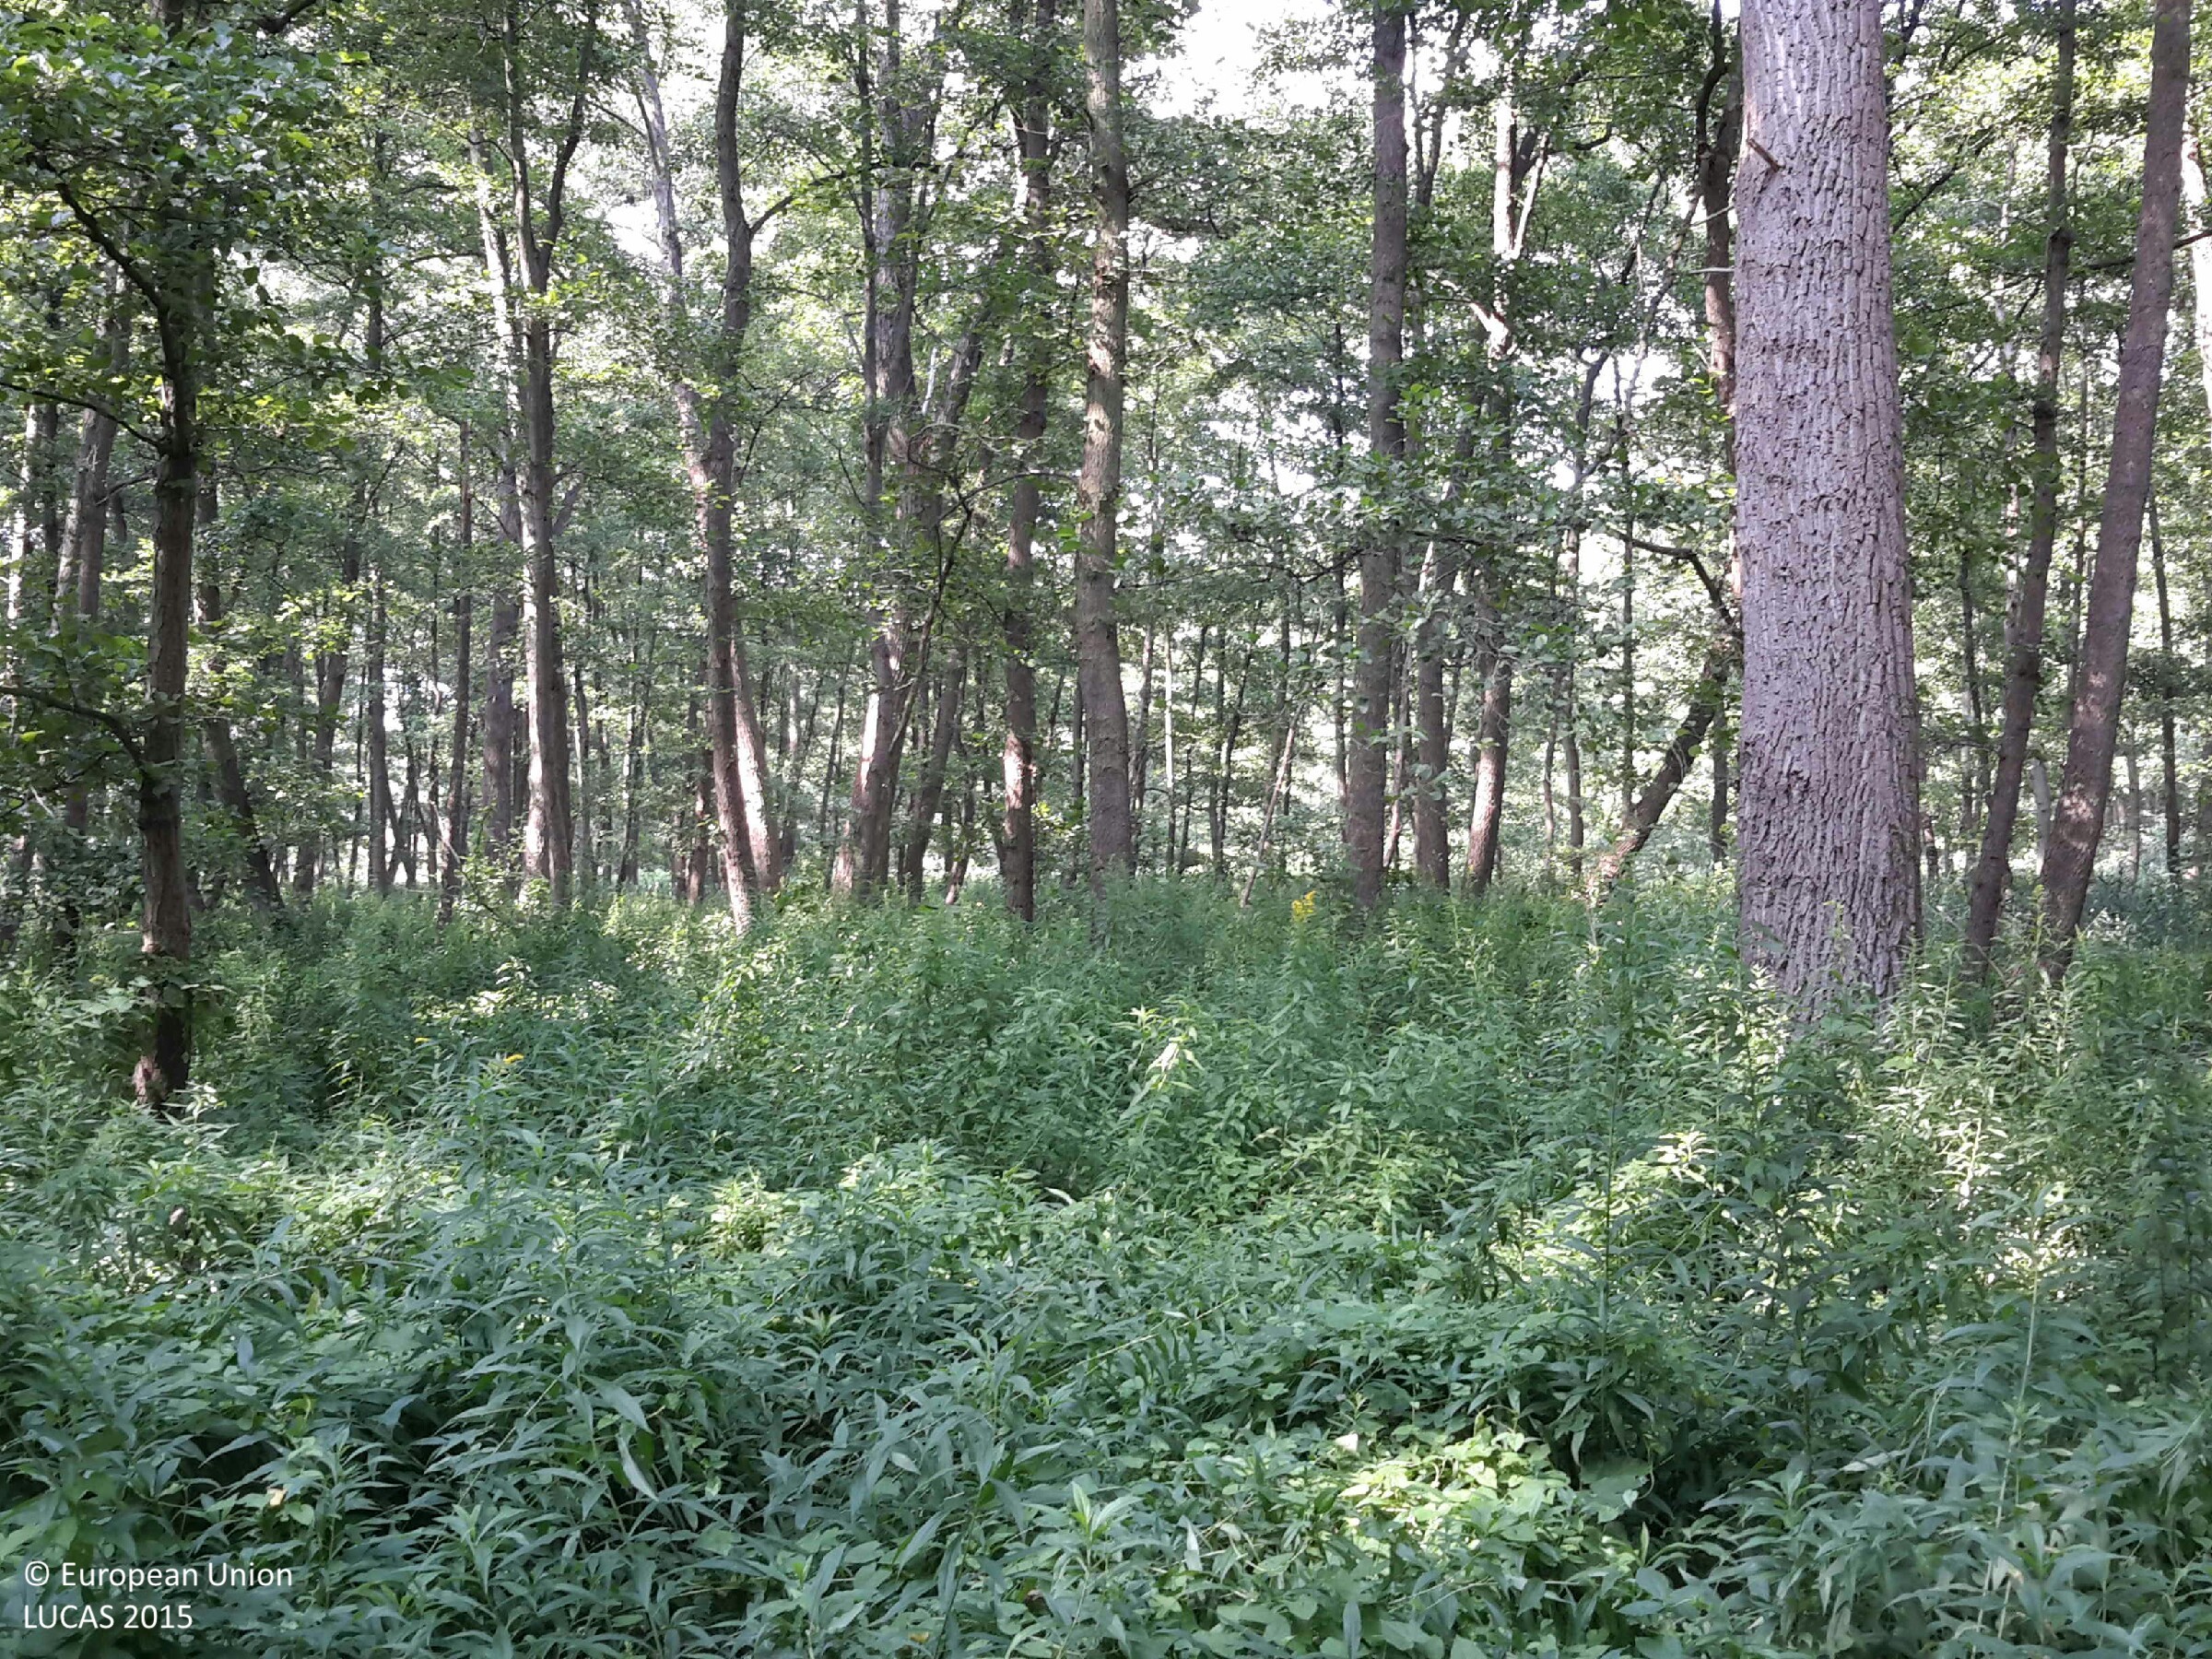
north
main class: Woodland
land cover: Broadleaved woodland
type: mesophytic deciduous forest
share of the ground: > 75 %
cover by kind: broadleaved forest trees 90 %, herbaceous plants 10 %
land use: Forestry
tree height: > 5 m
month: August
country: HU
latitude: 47.7463
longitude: 17.3034
